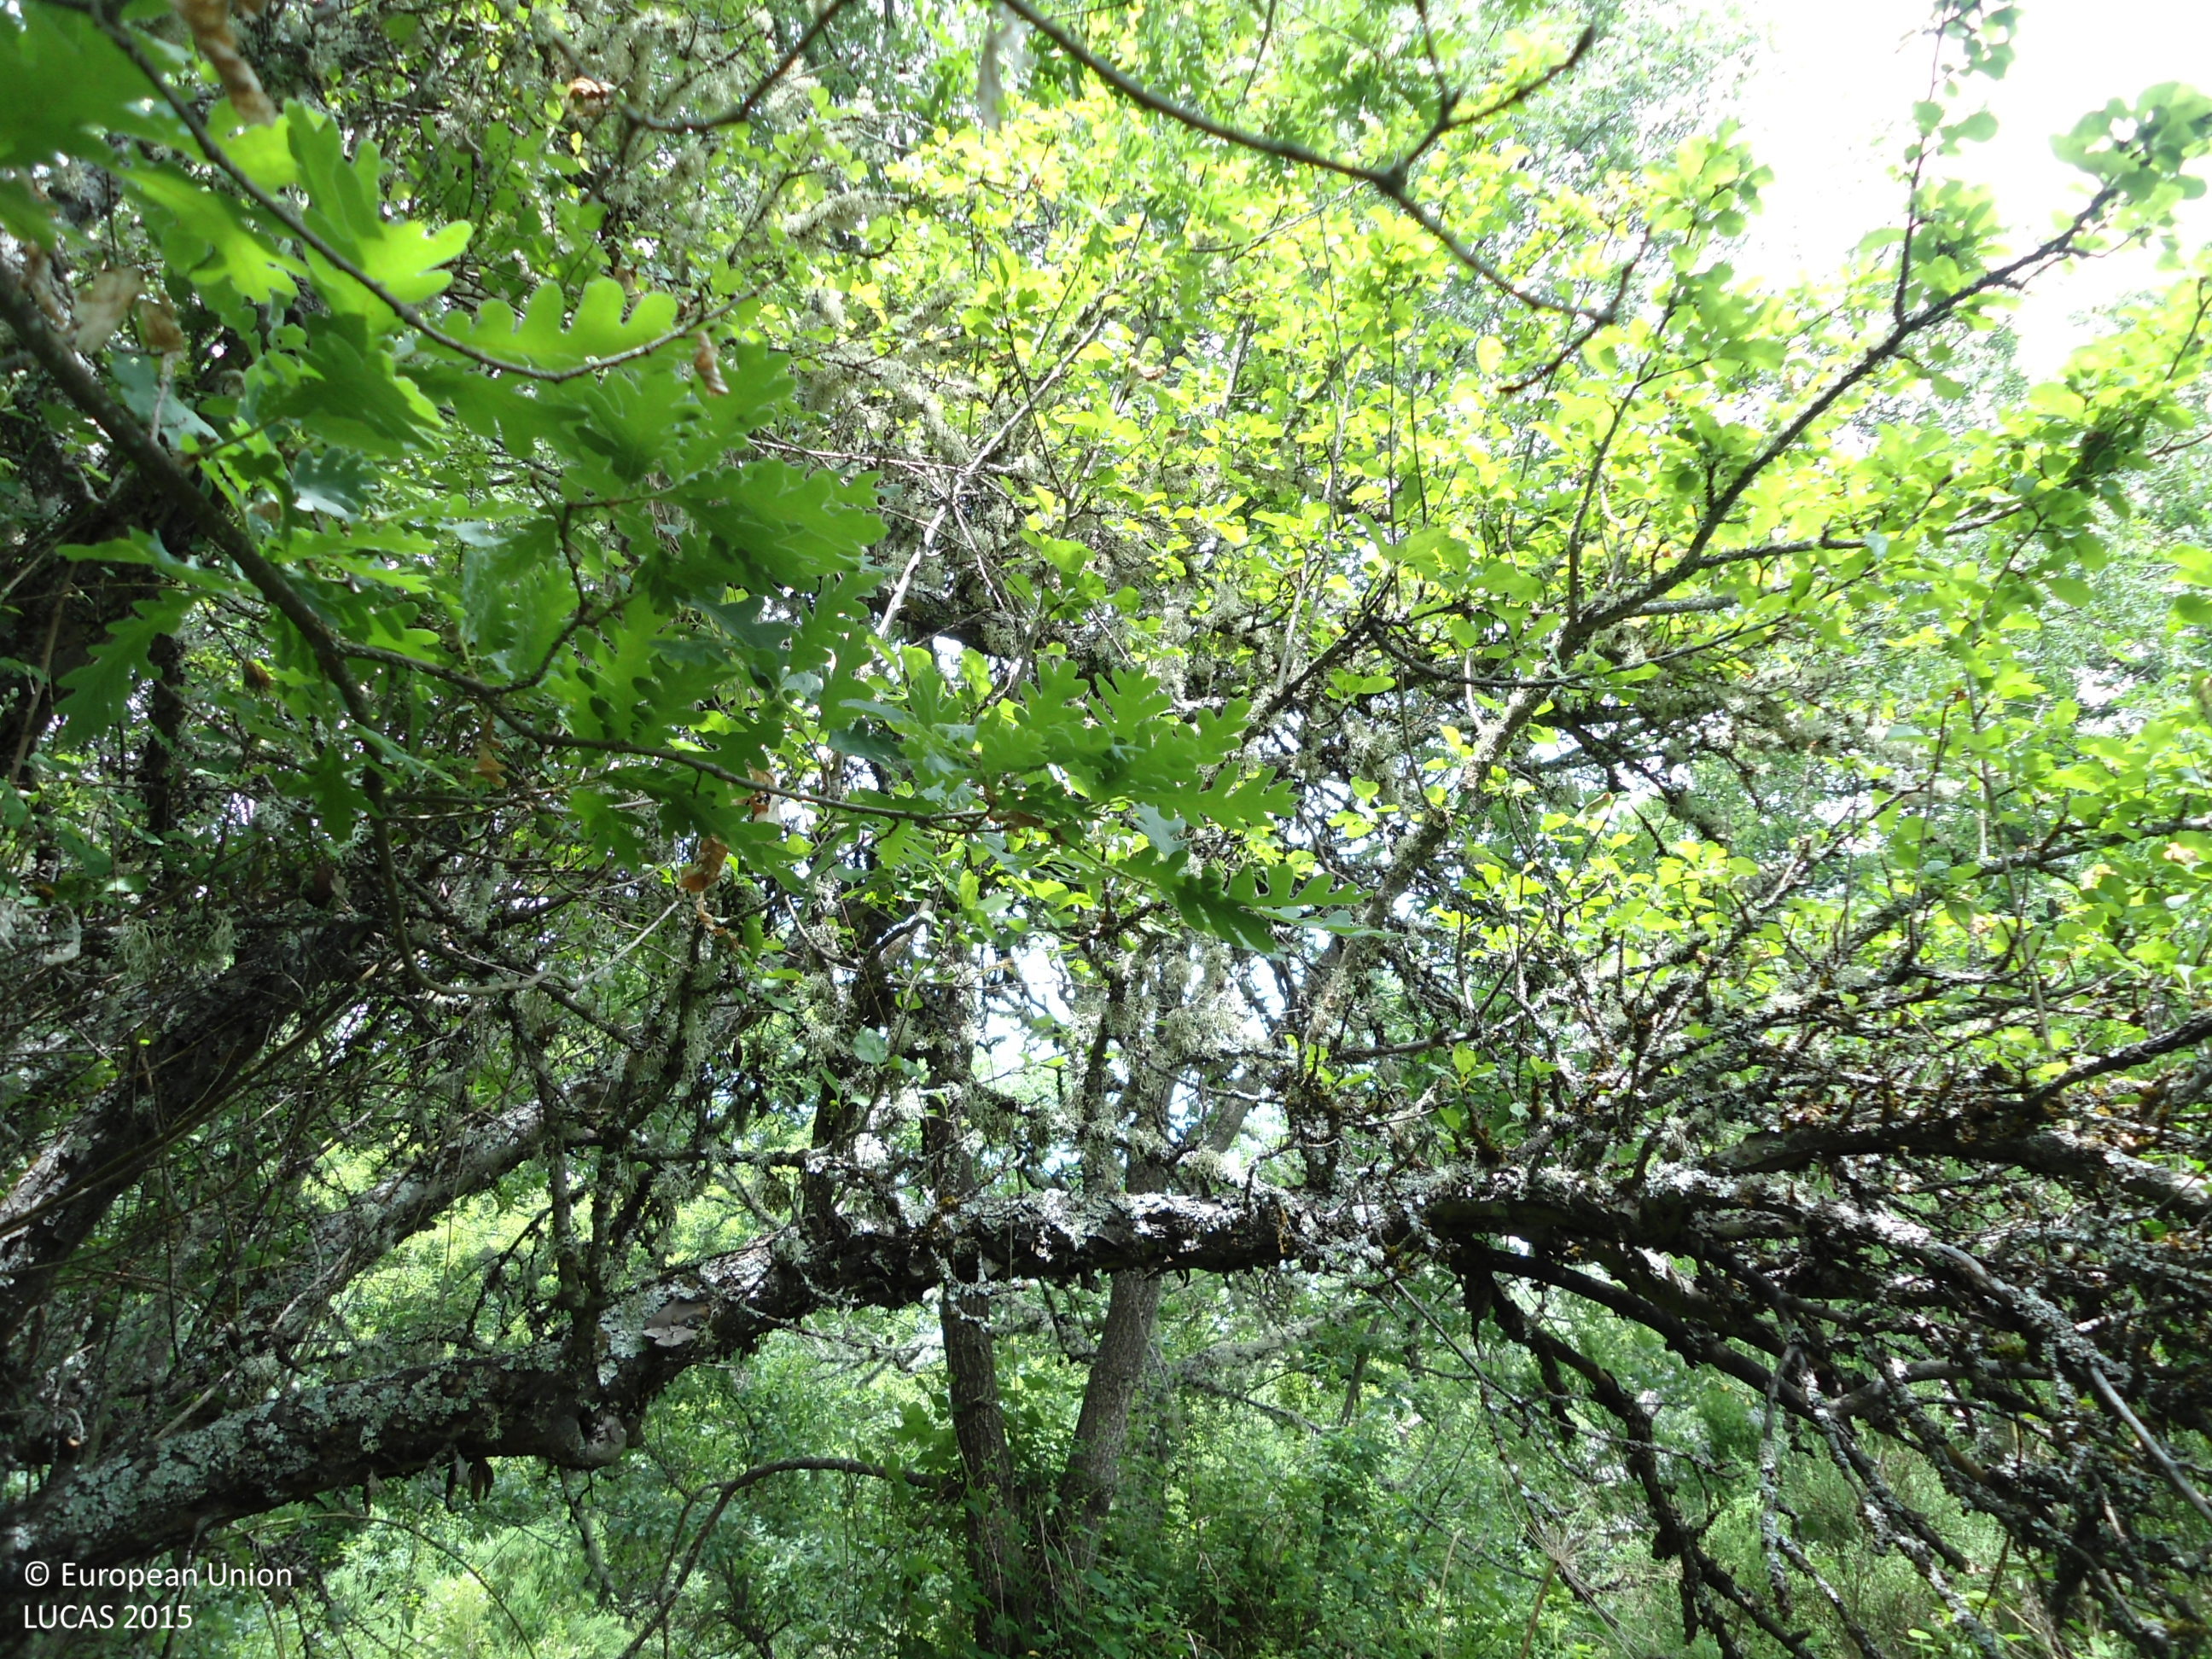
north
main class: Woodland
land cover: Broadleaved woodland
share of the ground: > 75 %
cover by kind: broadleaved forest trees 90 %, shrubs 10 %
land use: Forestry
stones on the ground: < 10 %
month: June
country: ES
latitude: 42.0978
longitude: -6.6187
